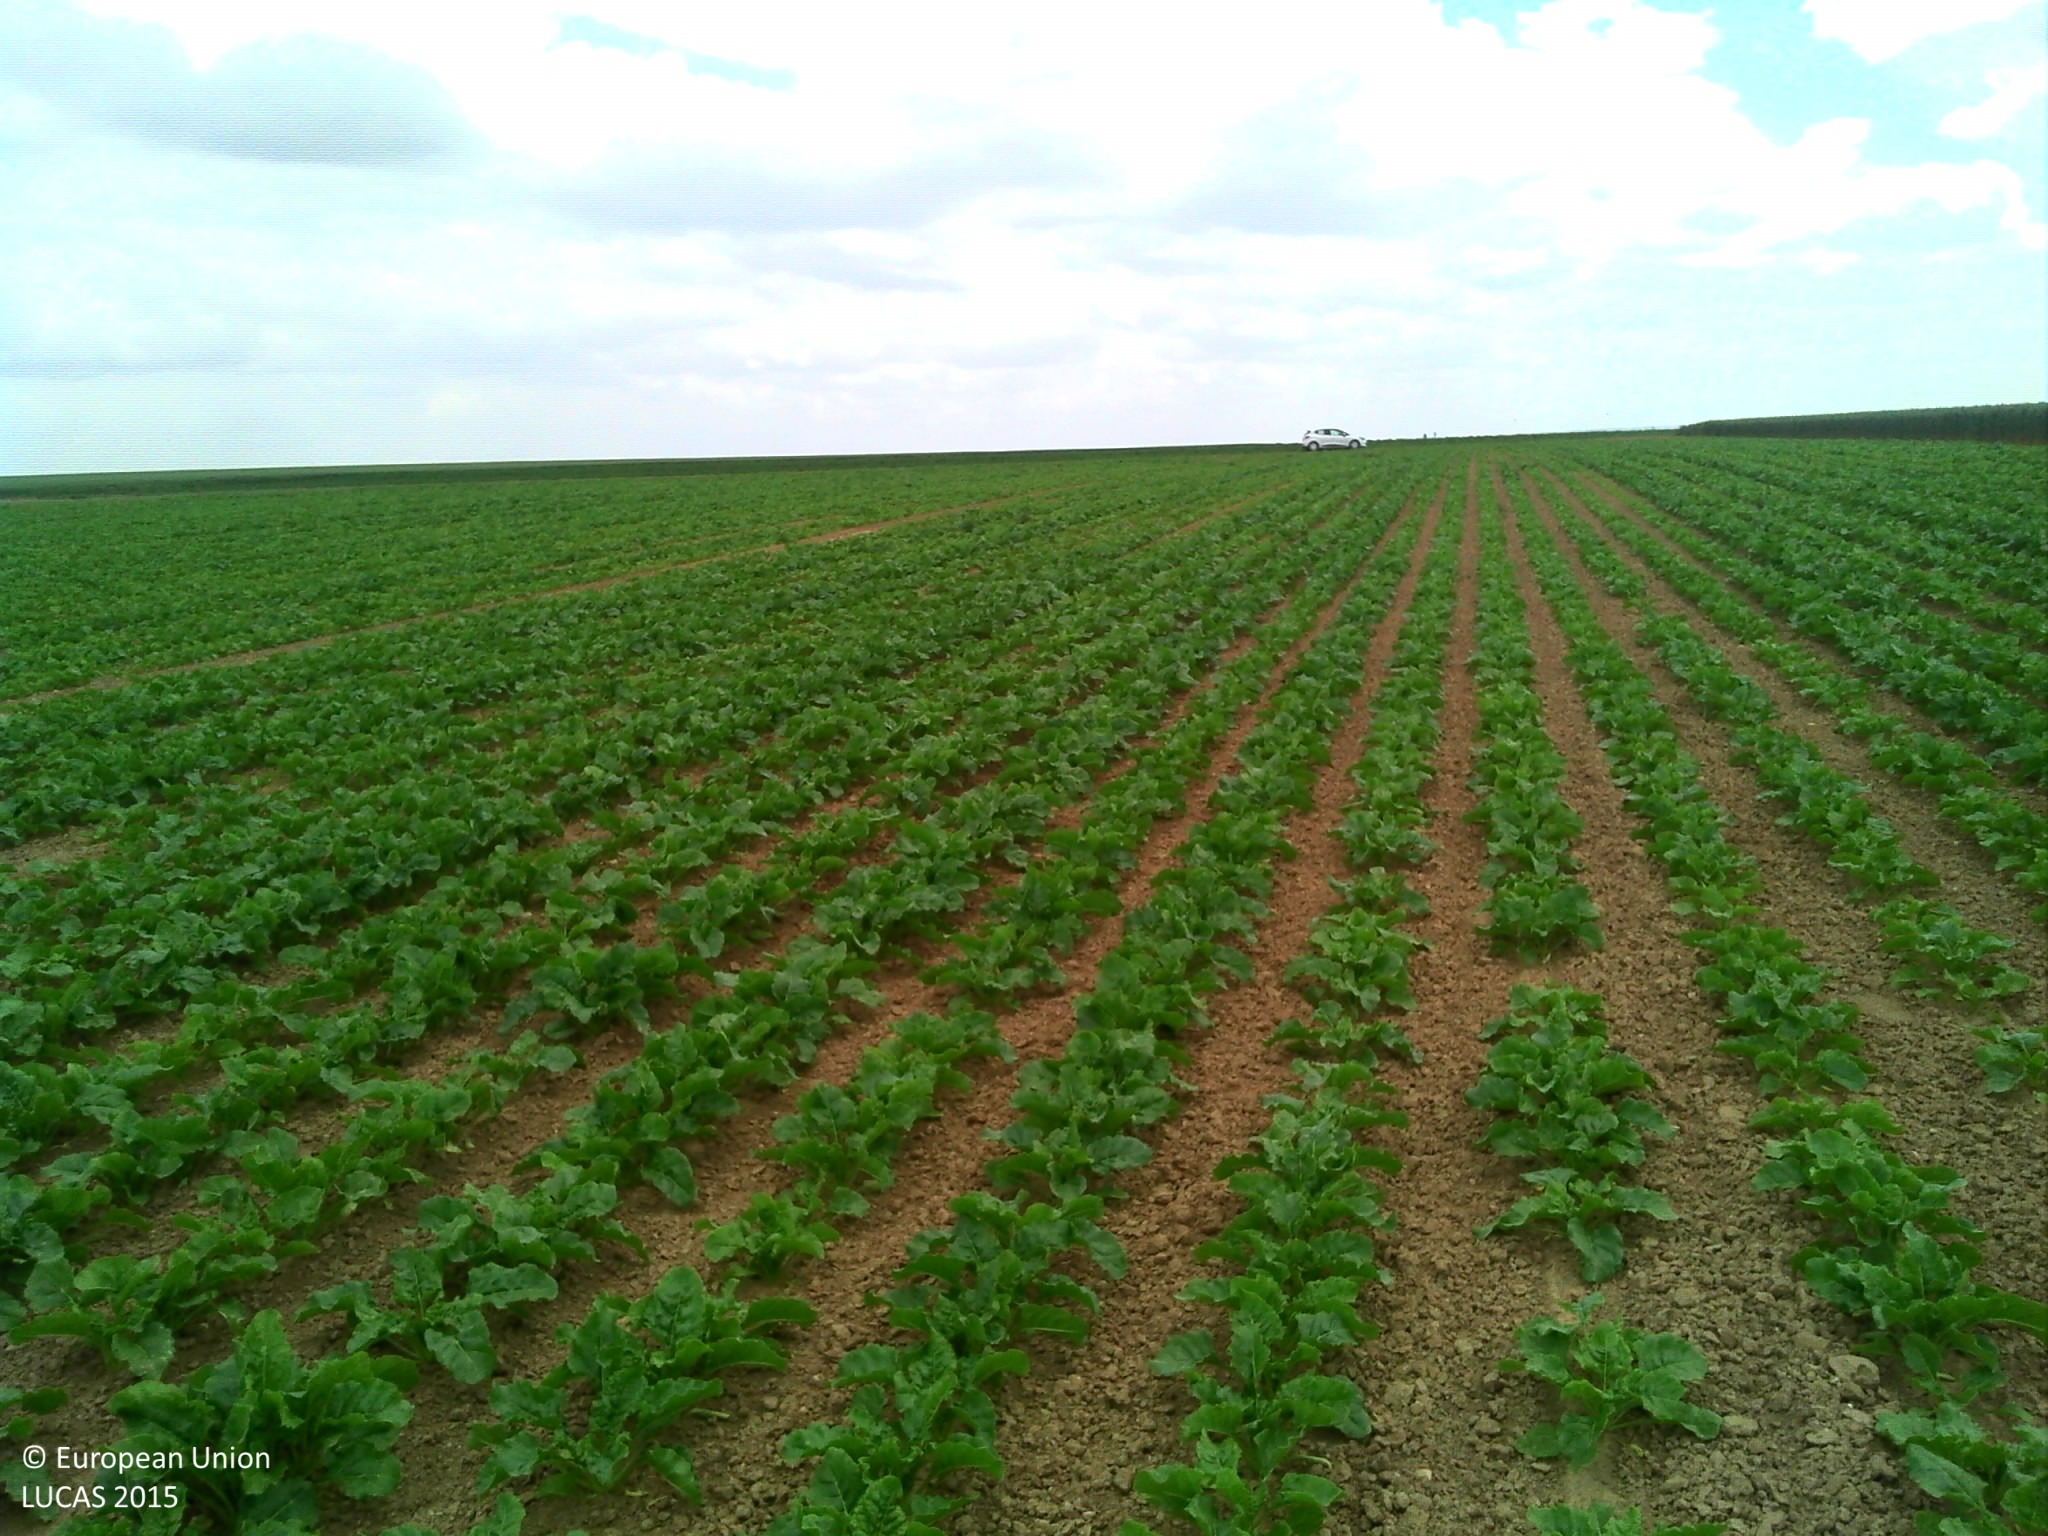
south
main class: Cropland
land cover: Sugar beet
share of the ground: 50 - 75 %
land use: Agriculture (excluding fallow land and kitchen gardens)
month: June
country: FR
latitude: 49.4784
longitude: 3.2426
